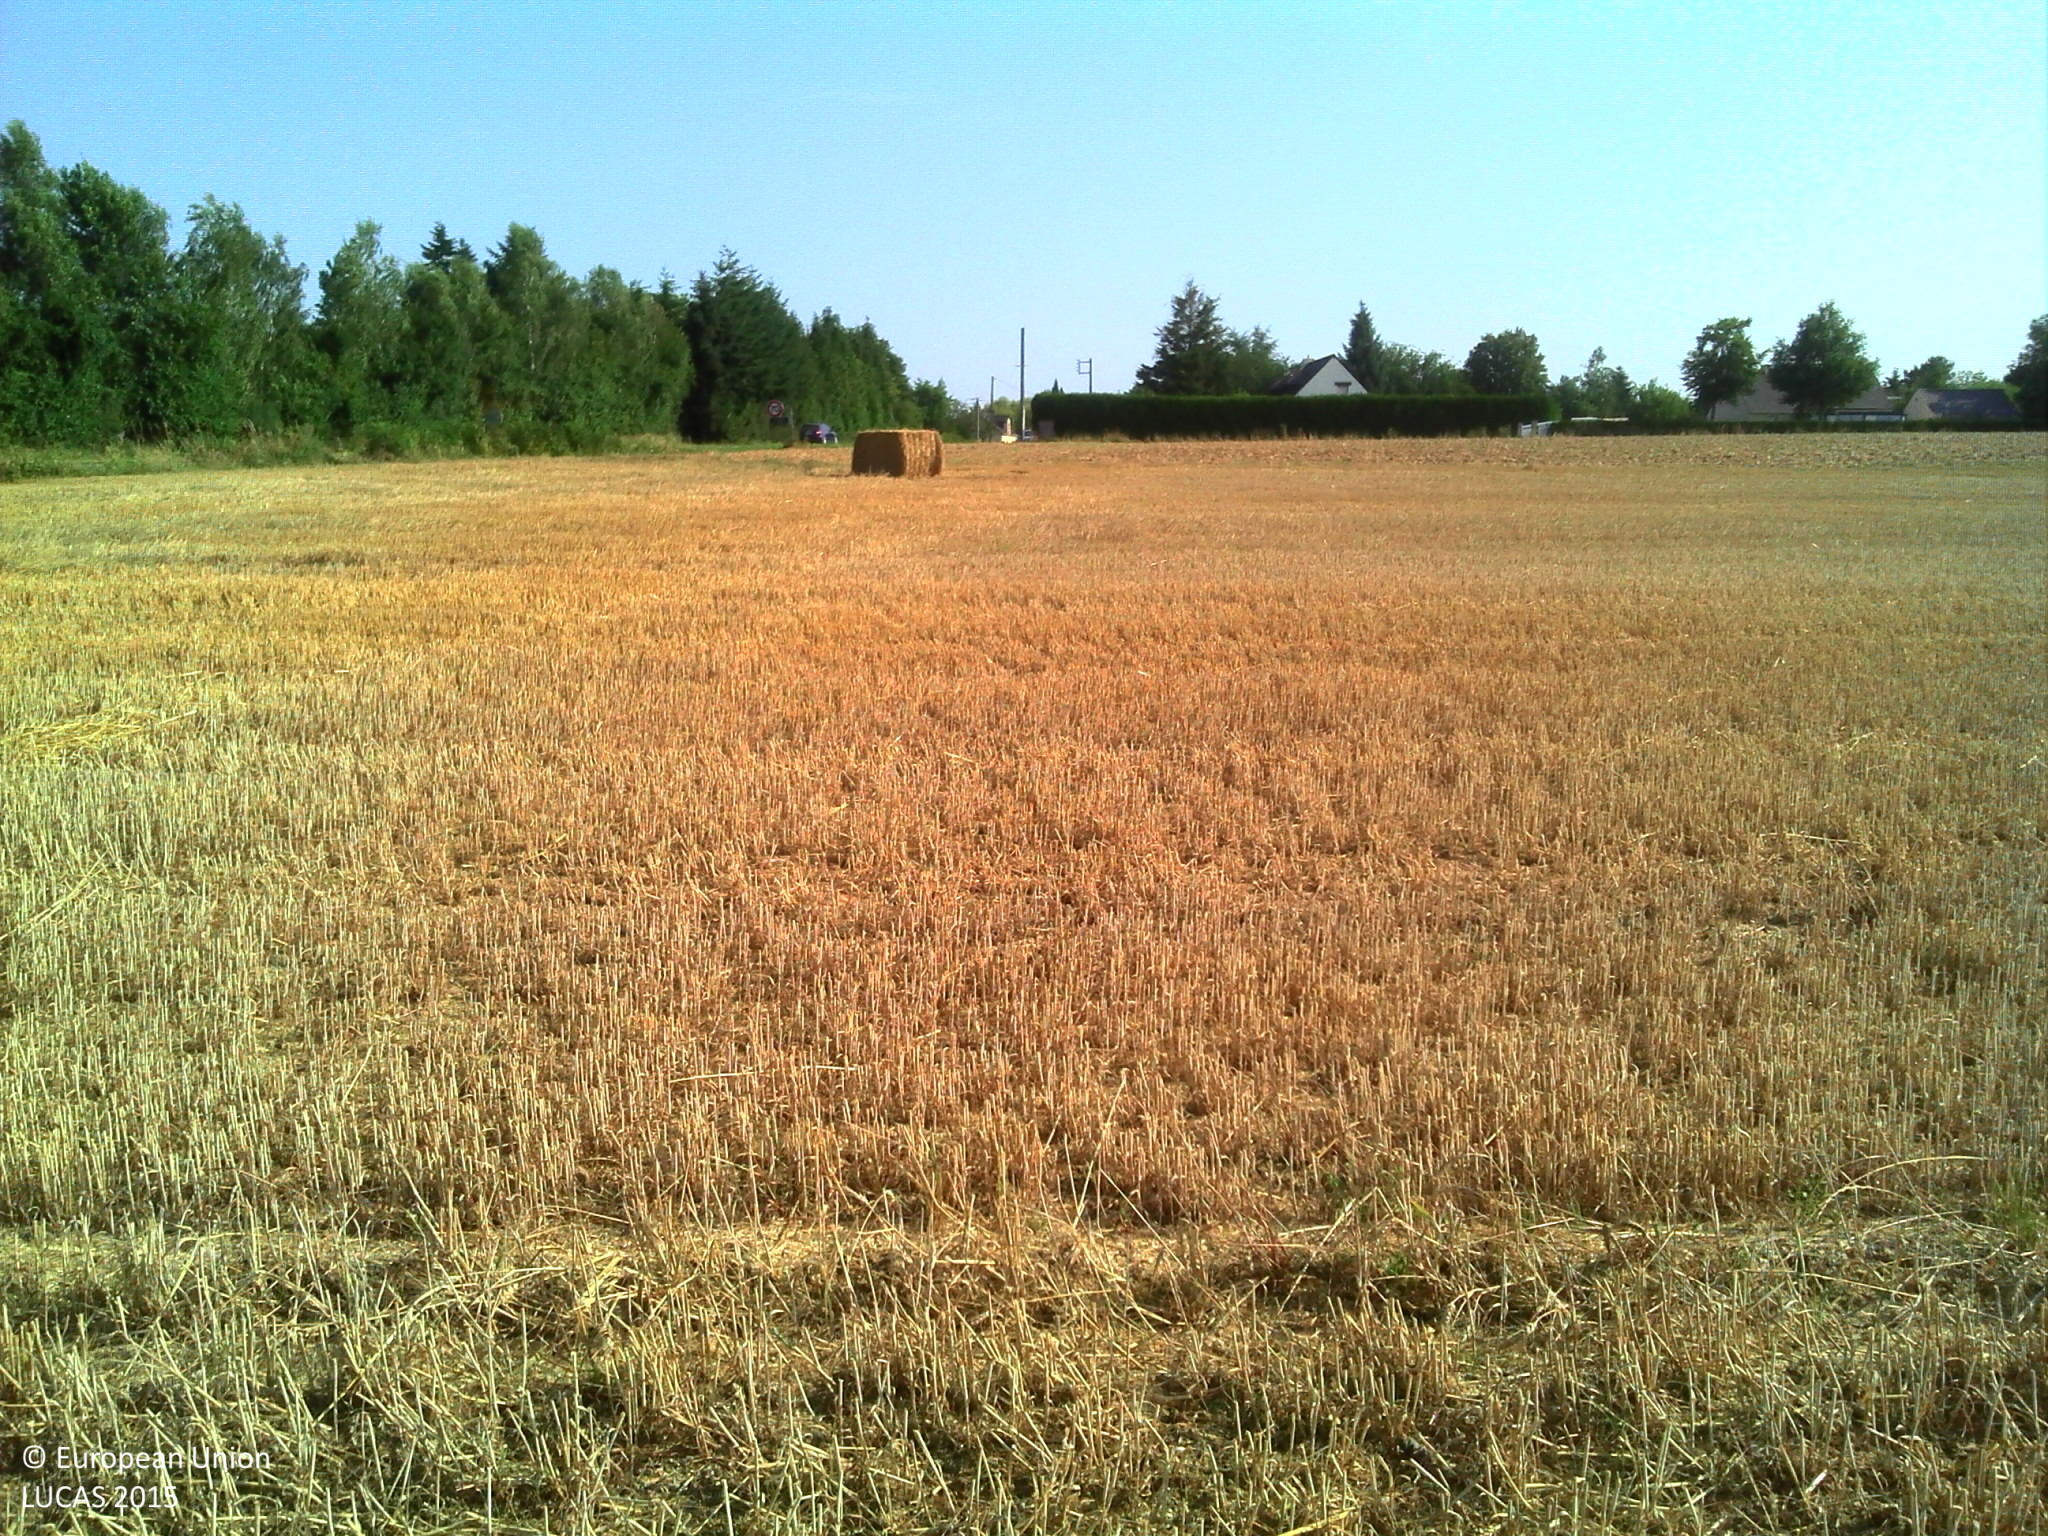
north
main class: Cropland
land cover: Common wheat
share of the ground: > 75 %
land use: Agriculture (excluding fallow land and kitchen gardens)
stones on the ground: 10 - 25 %
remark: Harvested field
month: July
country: FR
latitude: 47.6005
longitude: -1.8455
